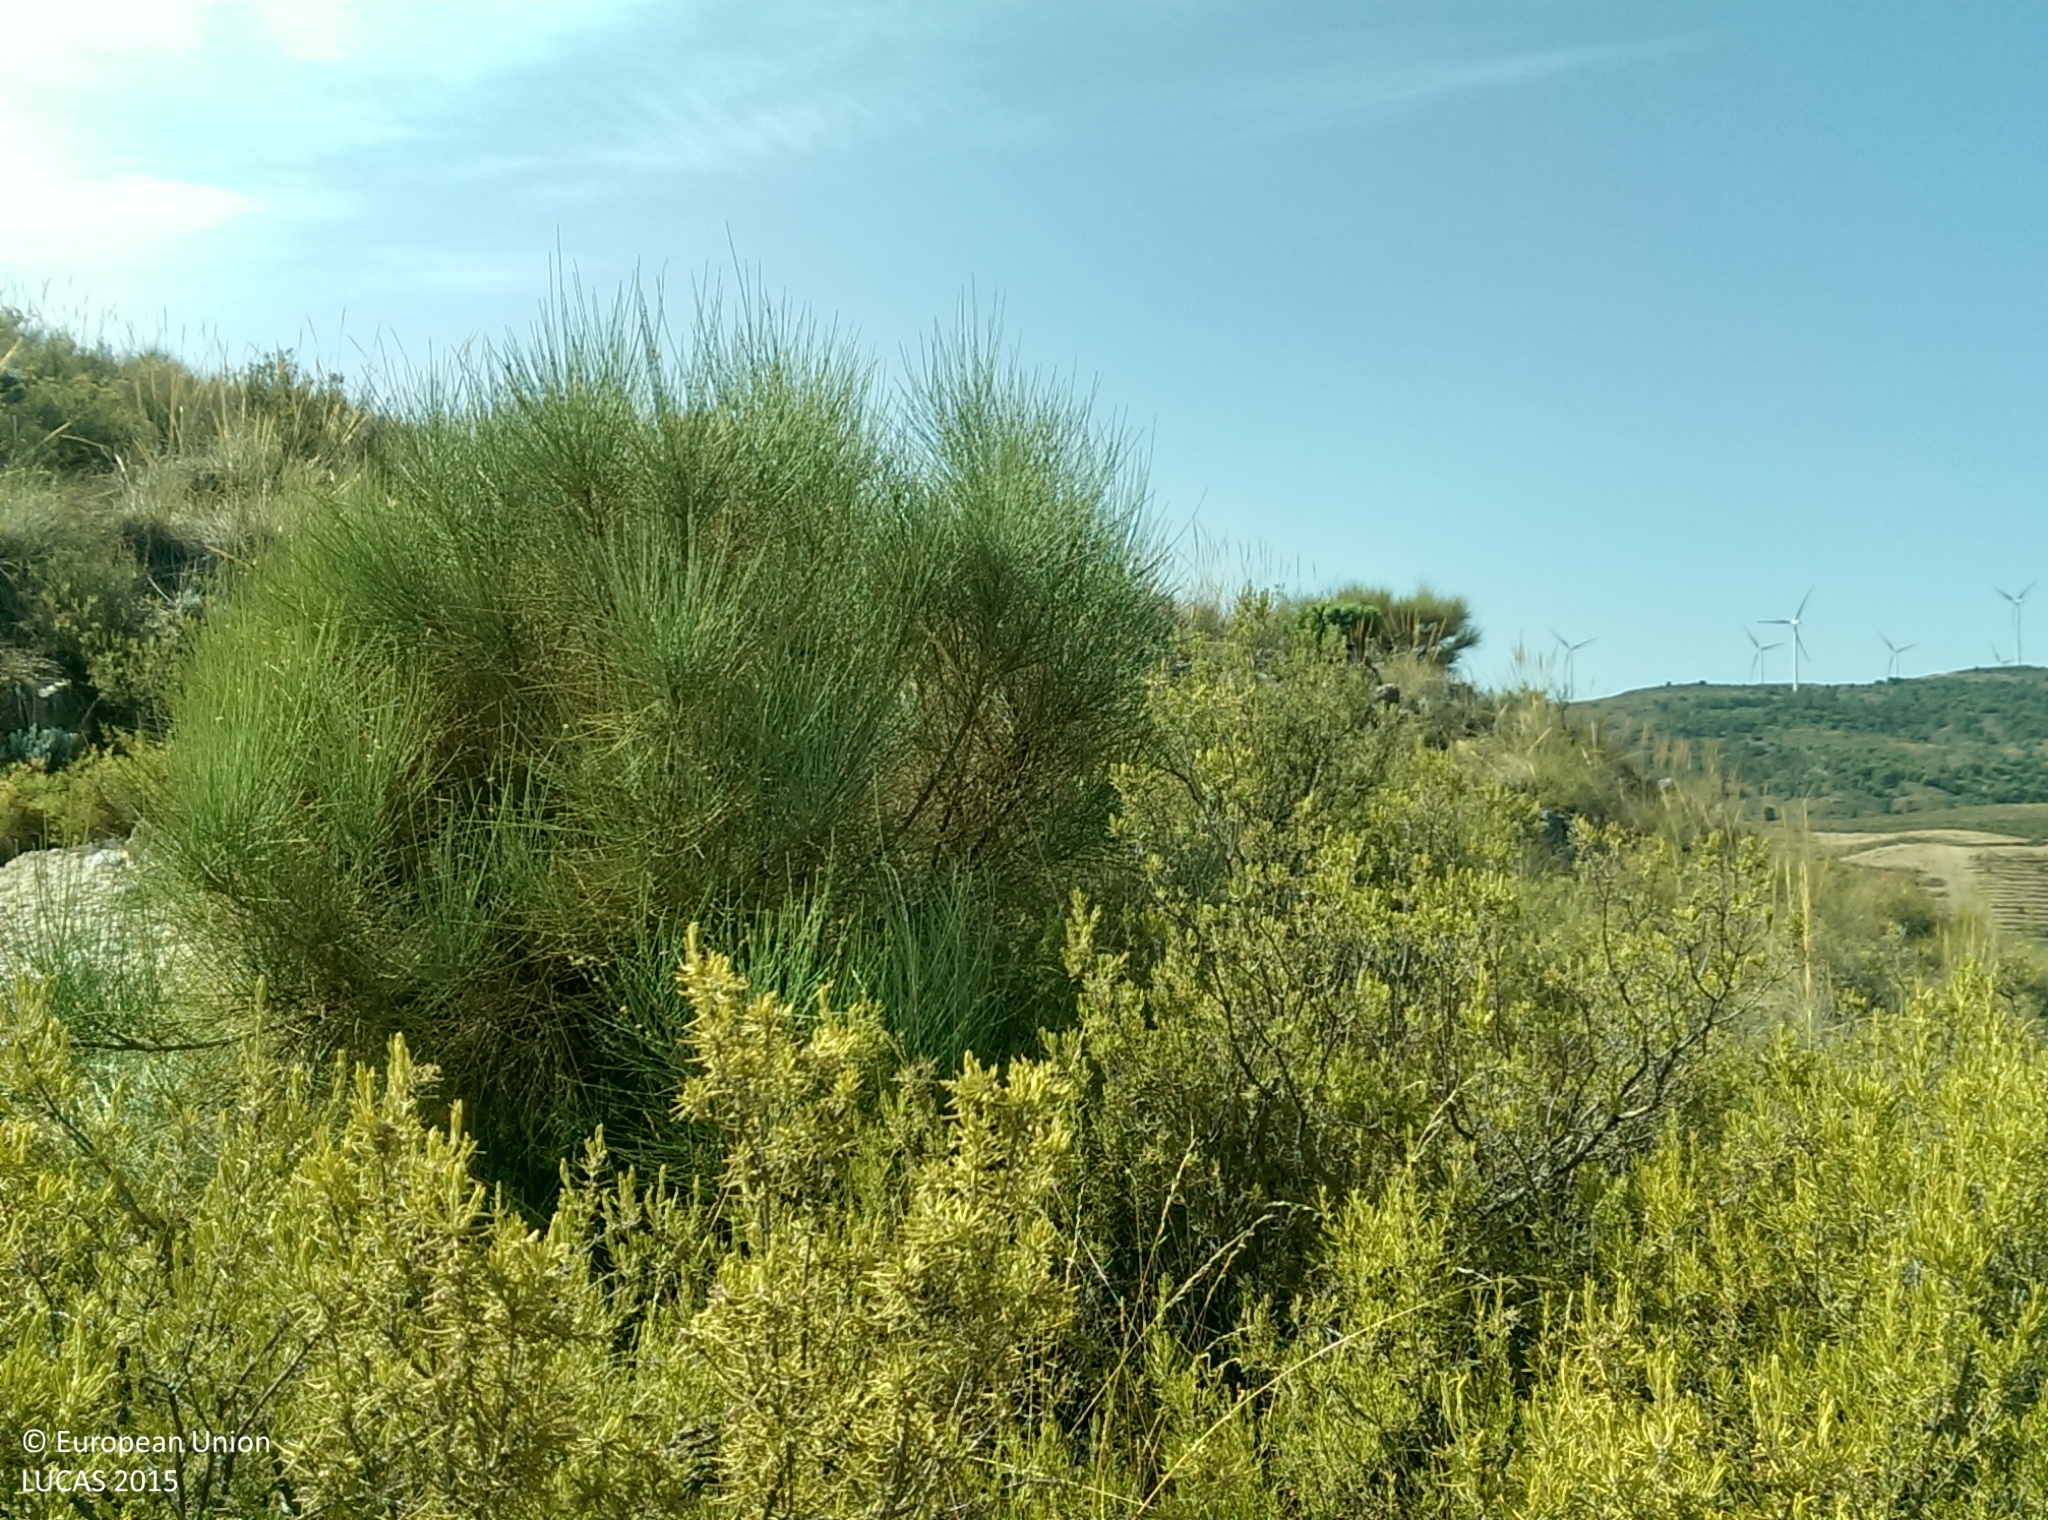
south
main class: Shrubland
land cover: Shrubland without tree cover
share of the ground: 50 - 75 %
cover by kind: shrubs 60 %, herbaceous plants 30 %, unconsolidated bare surface 10 %
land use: Abandoned areas
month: August
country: ES
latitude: 36.9775
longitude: -3.6579
